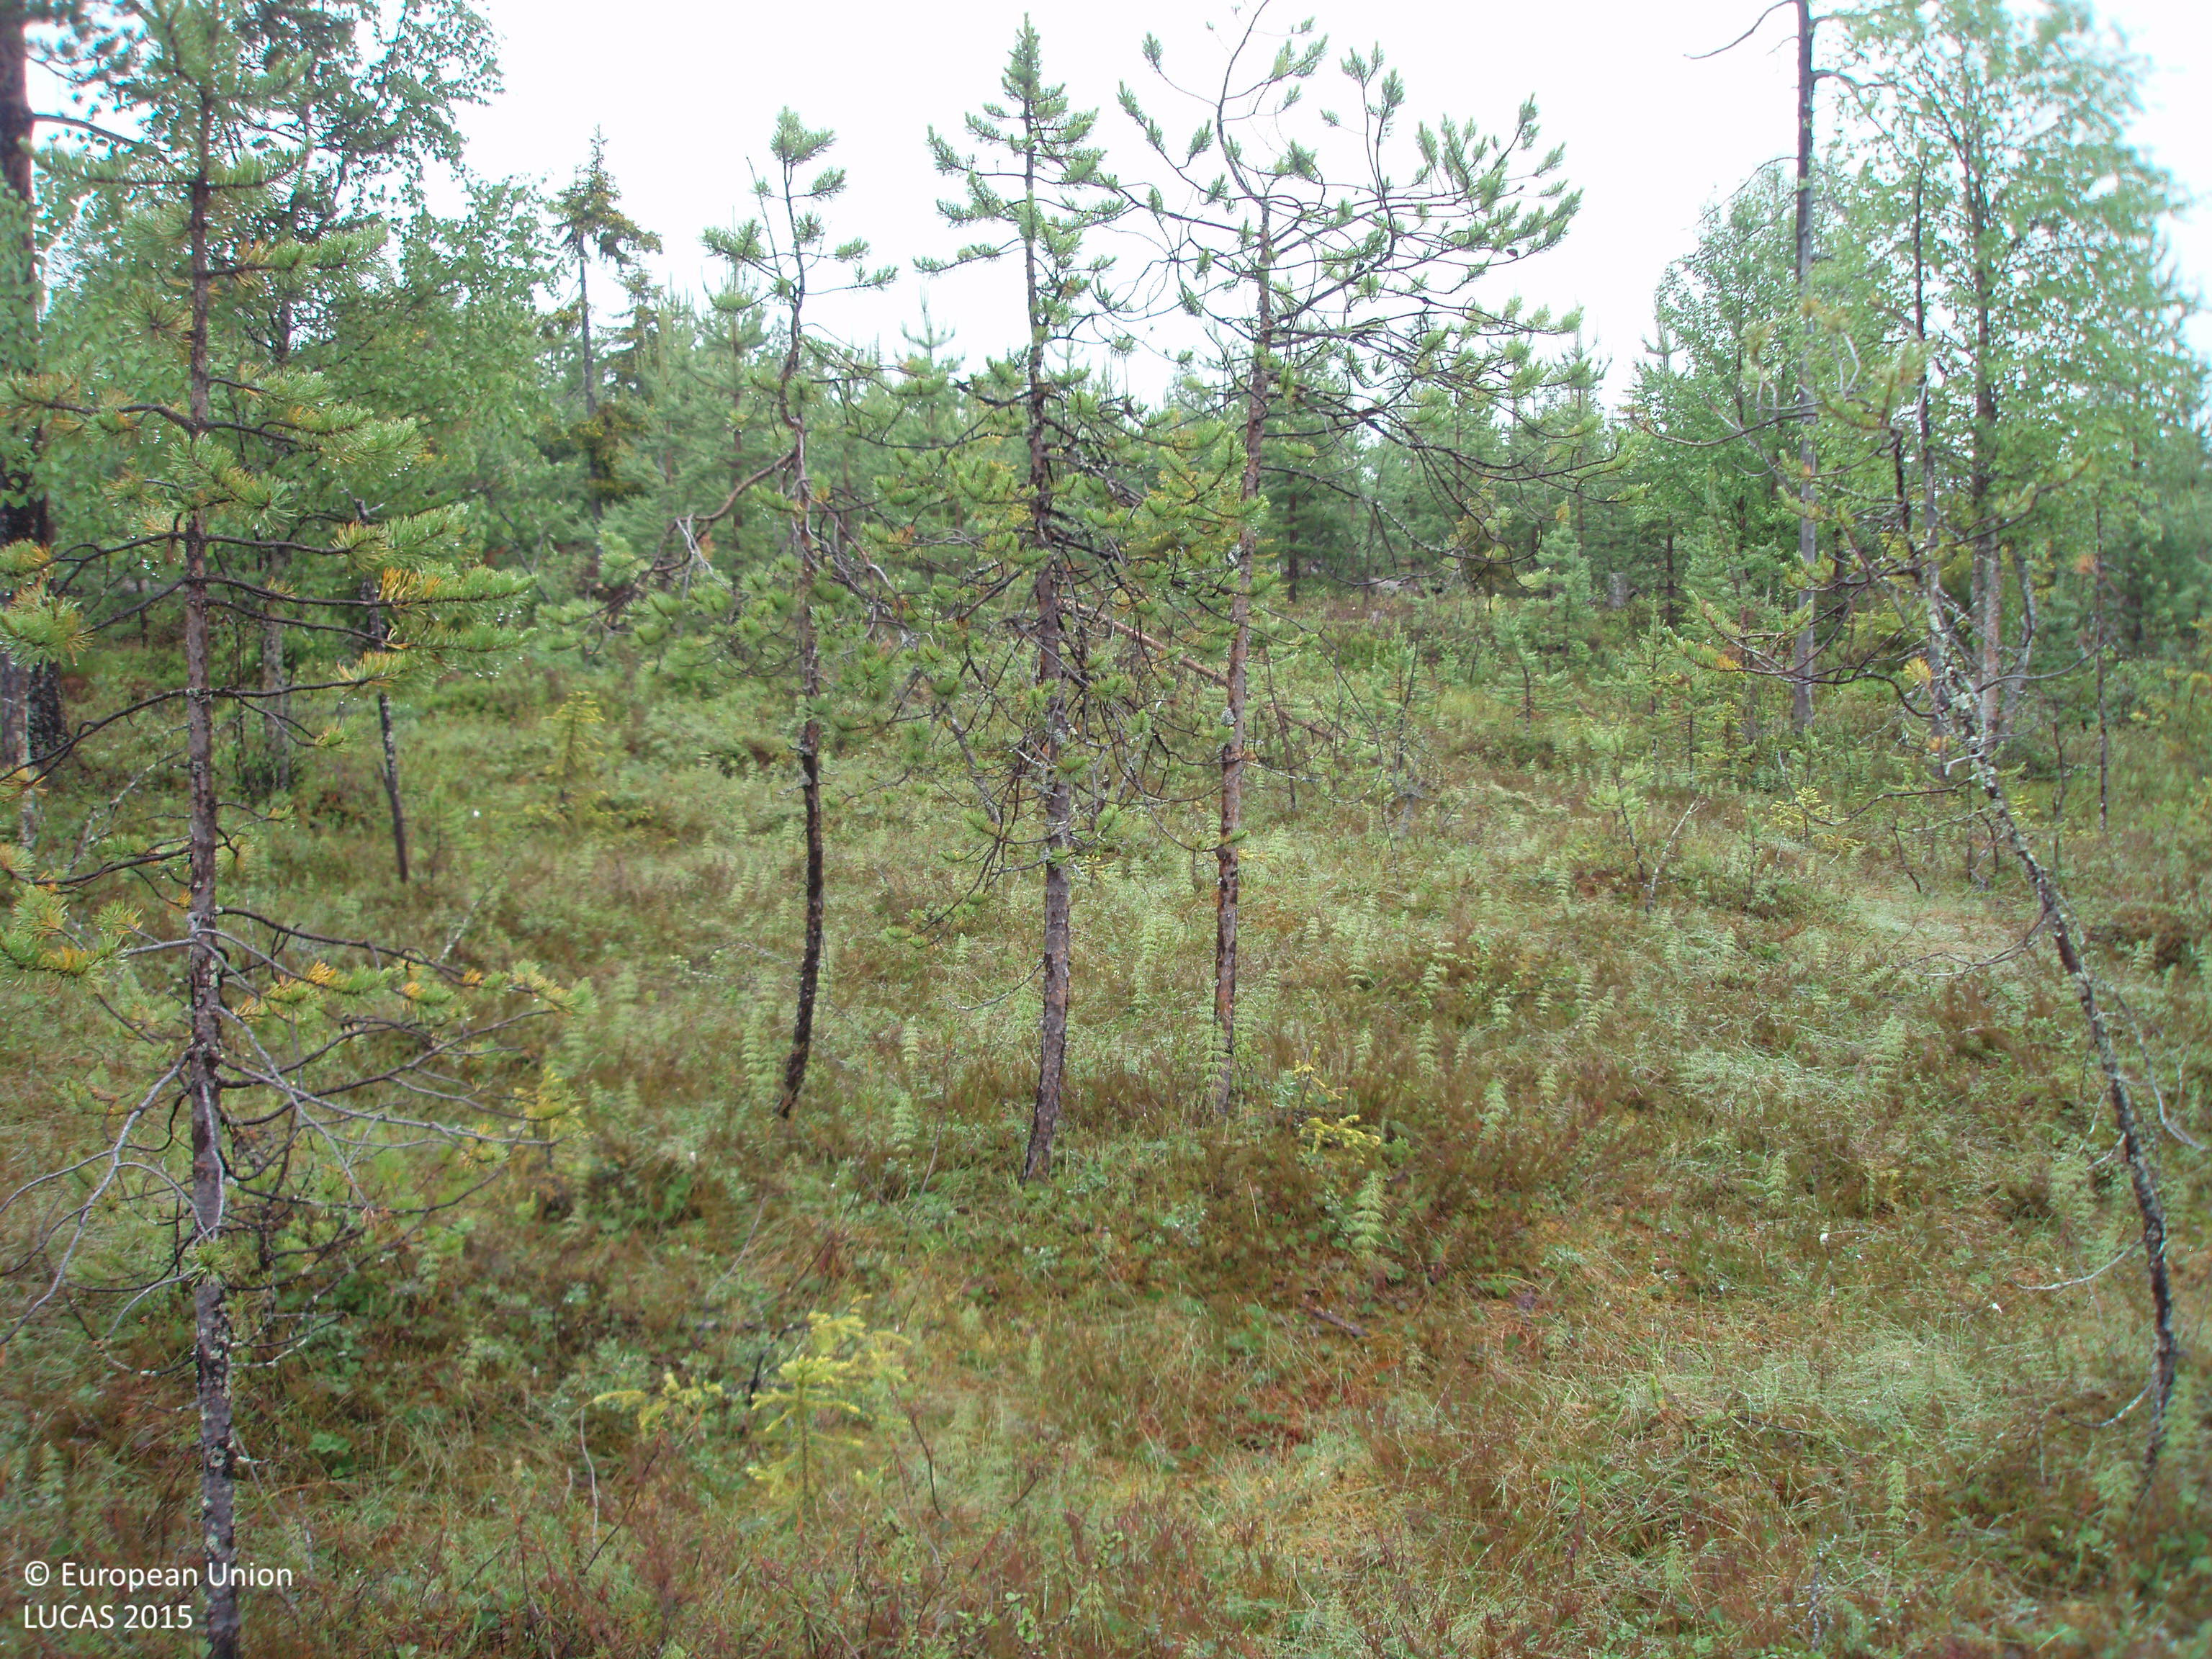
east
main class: Woodland
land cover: Pine dominated coniferous woodland
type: mire and swamp forests
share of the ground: 25 - 50 %
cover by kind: shrubs 40 %, lichens and mosses 30 %, coniferous forest trees 25 %, herbaceous plants 5 %
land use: Forestry
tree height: > 5 m
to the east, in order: Pine dominated coniferous woodland; Ditches and canals; Pine dominated coniferous woodland; Ditches and canals; Pine dominated coniferous woodland; Ditches and canals; Pine dominated coniferous woodland; Ditches and canals; Pine dominated coniferous woodland; Ditches and canals; Pine dominated coniferous woodland; Ditches and canals; Pine dominated coniferous woodland; Ditches and canals; Pine dominated coniferous woodland; Ditches and canals; Pine dominated coniferous woodland; Ditches and canals; Pine dominated coniferous woodland; Ditches and canals; Pine dominated coniferous woodland; Ditches and canals; Pine dominated coniferous woodland; Ditches and canals; Pine dominated coniferous woodland; Ditches and canals; Pine dominated coniferous woodland; Ditches and canals; Pine dominated coniferous woodland; Ditches and canals; Pine dominated coniferous woodland; Ditches and canals; Pine dominated coniferous woodland; Ditches and canals; Pine dominated coniferous woodland; Ditches and canals; Pine dominated coniferous woodland; Ditches and canals; Pine dominated coniferous woodland; Ditches and canals; Pine dominated coniferous woodland; Ditches and canals; Pine dominated coniferous woodland; Ditches and canals; Pine dominated coniferous woodland; Ditches and canals; Pine dominated coniferous woodland; Ditches and canals; Pine dominated coniferous woodland; Ditches and canals; Pine dominated coniferous woodland; Ditches and canals; Pine dominated coniferous woodland; Ditches and canals; Pine dominated coniferous woodland
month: July
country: FI
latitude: 67.2871
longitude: 28.4420
